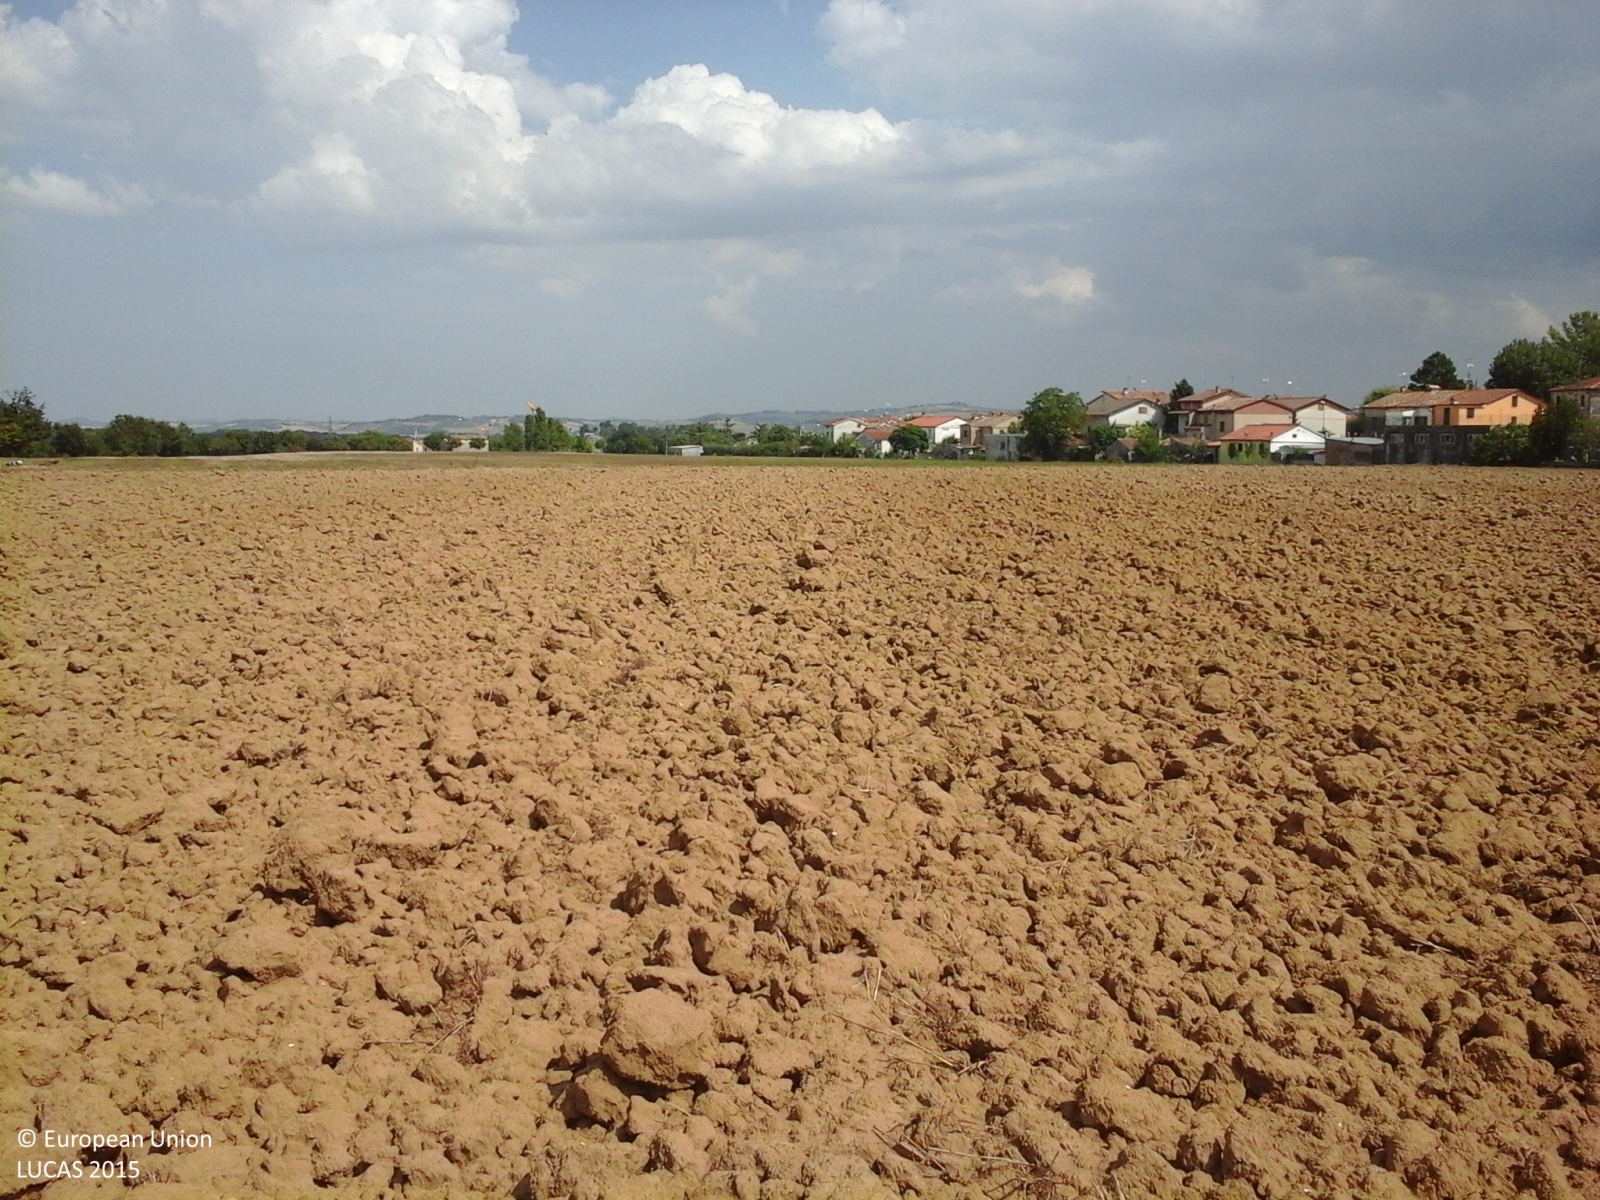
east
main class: Cropland
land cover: Durum wheat
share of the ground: < 10 %
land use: Agriculture (excluding fallow land and kitchen gardens)
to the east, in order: Durum wheat; Spontaneously vegetated surfaces
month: August
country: IT
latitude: 43.4897
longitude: 13.1700
